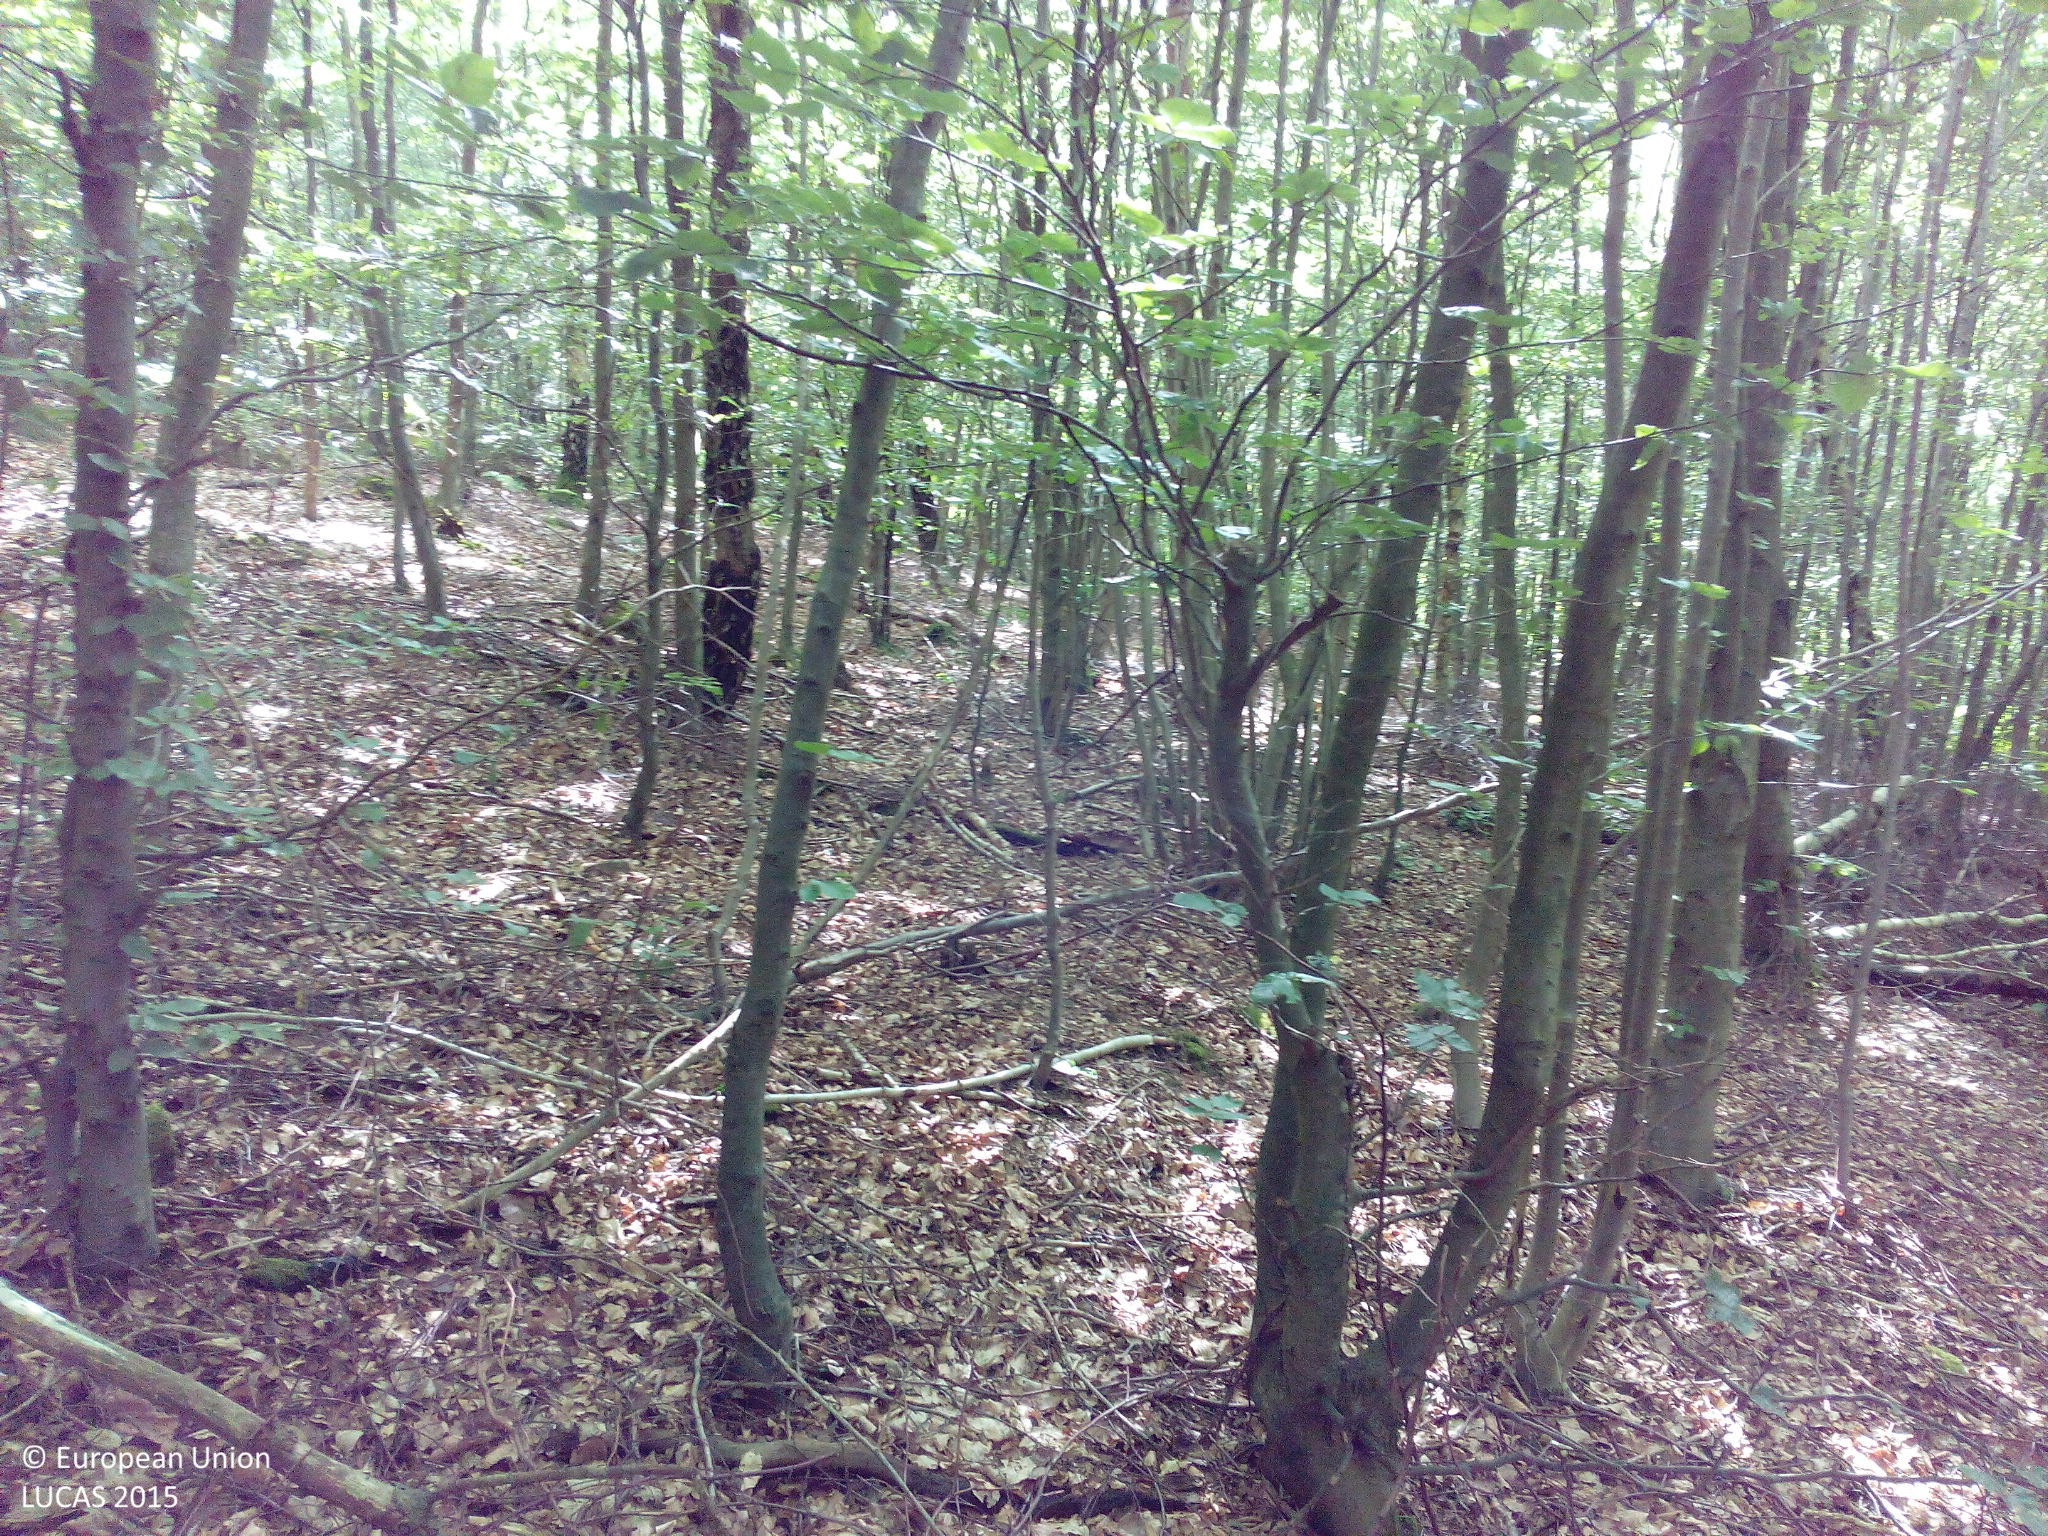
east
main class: Woodland
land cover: Broadleaved woodland
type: beech forest
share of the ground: > 75 %
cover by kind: broadleaved forest trees 100 %
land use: Forestry
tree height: > 5 m
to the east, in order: Broadleaved woodland; Grassland without tree/shrub cover; Spruce dominated coniferous woodland; Grassland without tree/shrub cover; Spruce dominated mixed woodland
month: July
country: DE
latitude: 50.5798
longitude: 9.9012
